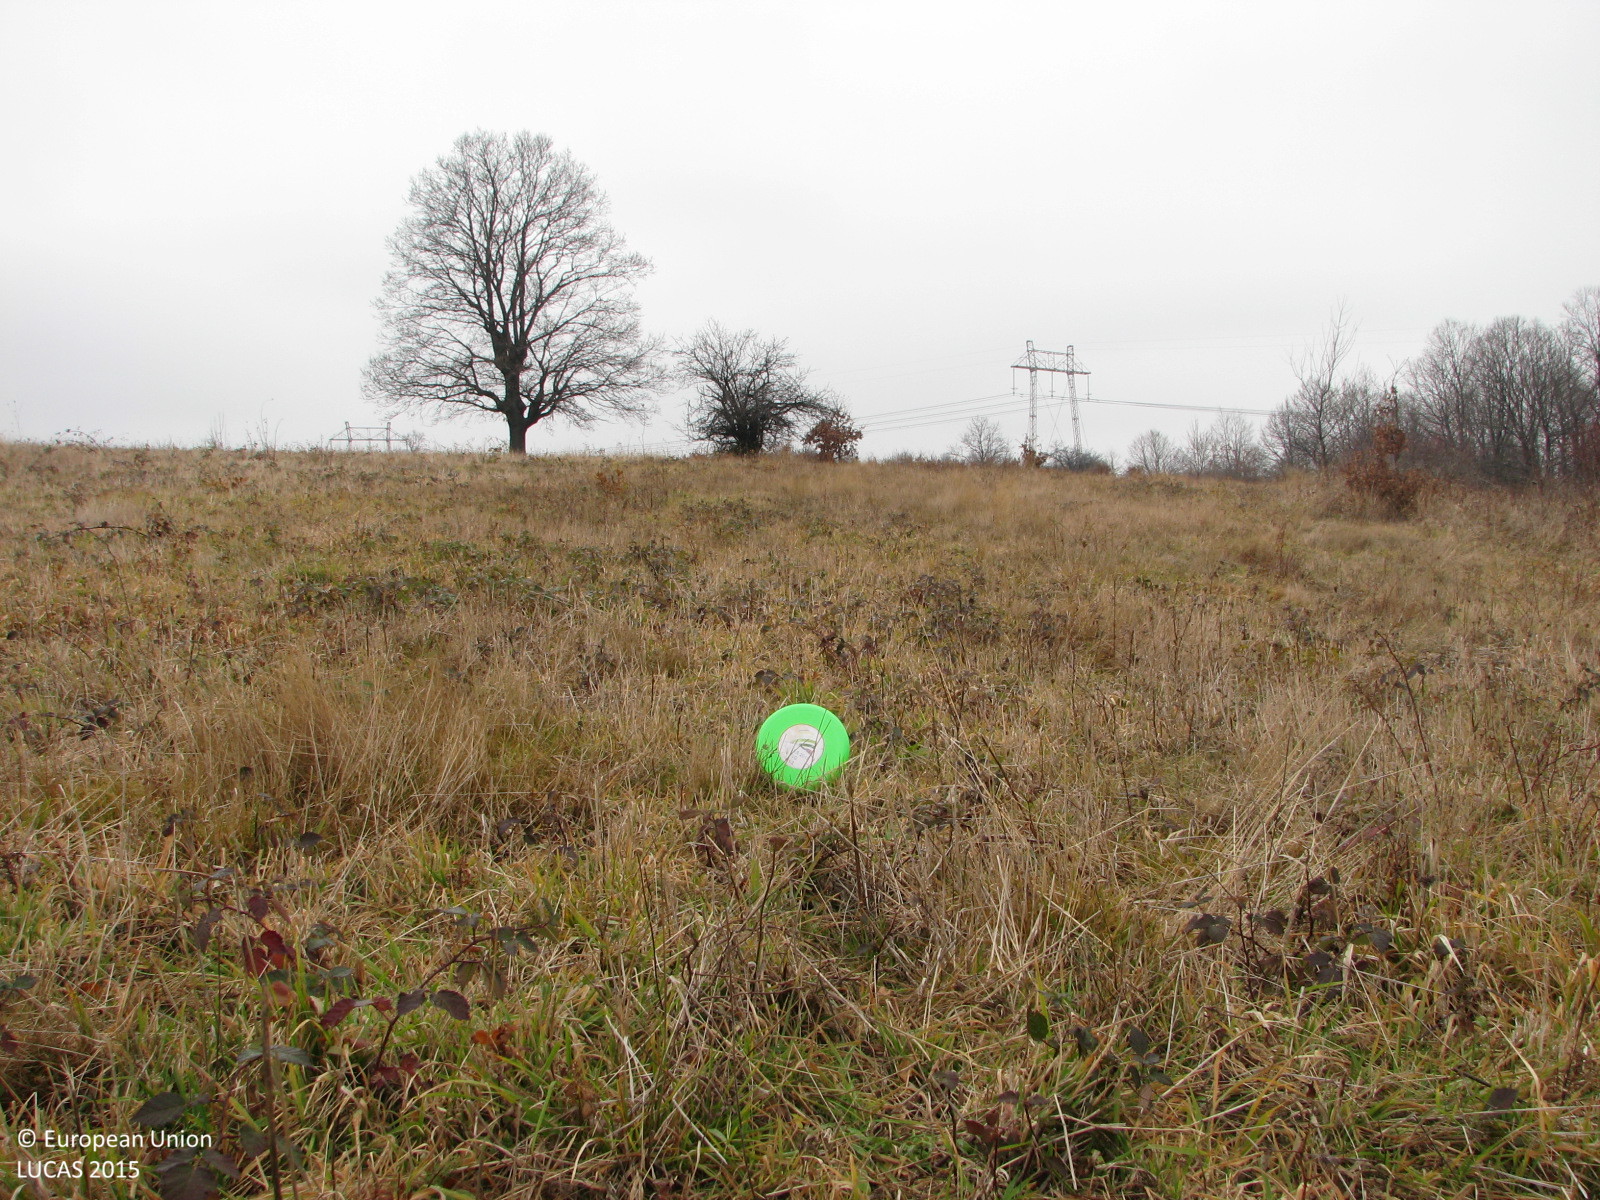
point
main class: Grassland
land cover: Grassland without tree/shrub cover
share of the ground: > 75 %
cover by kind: herbaceous plants 100 %
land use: Agriculture (excluding fallow land and kitchen gardens)
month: December
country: BG
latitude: 42.2374
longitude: 23.9135
